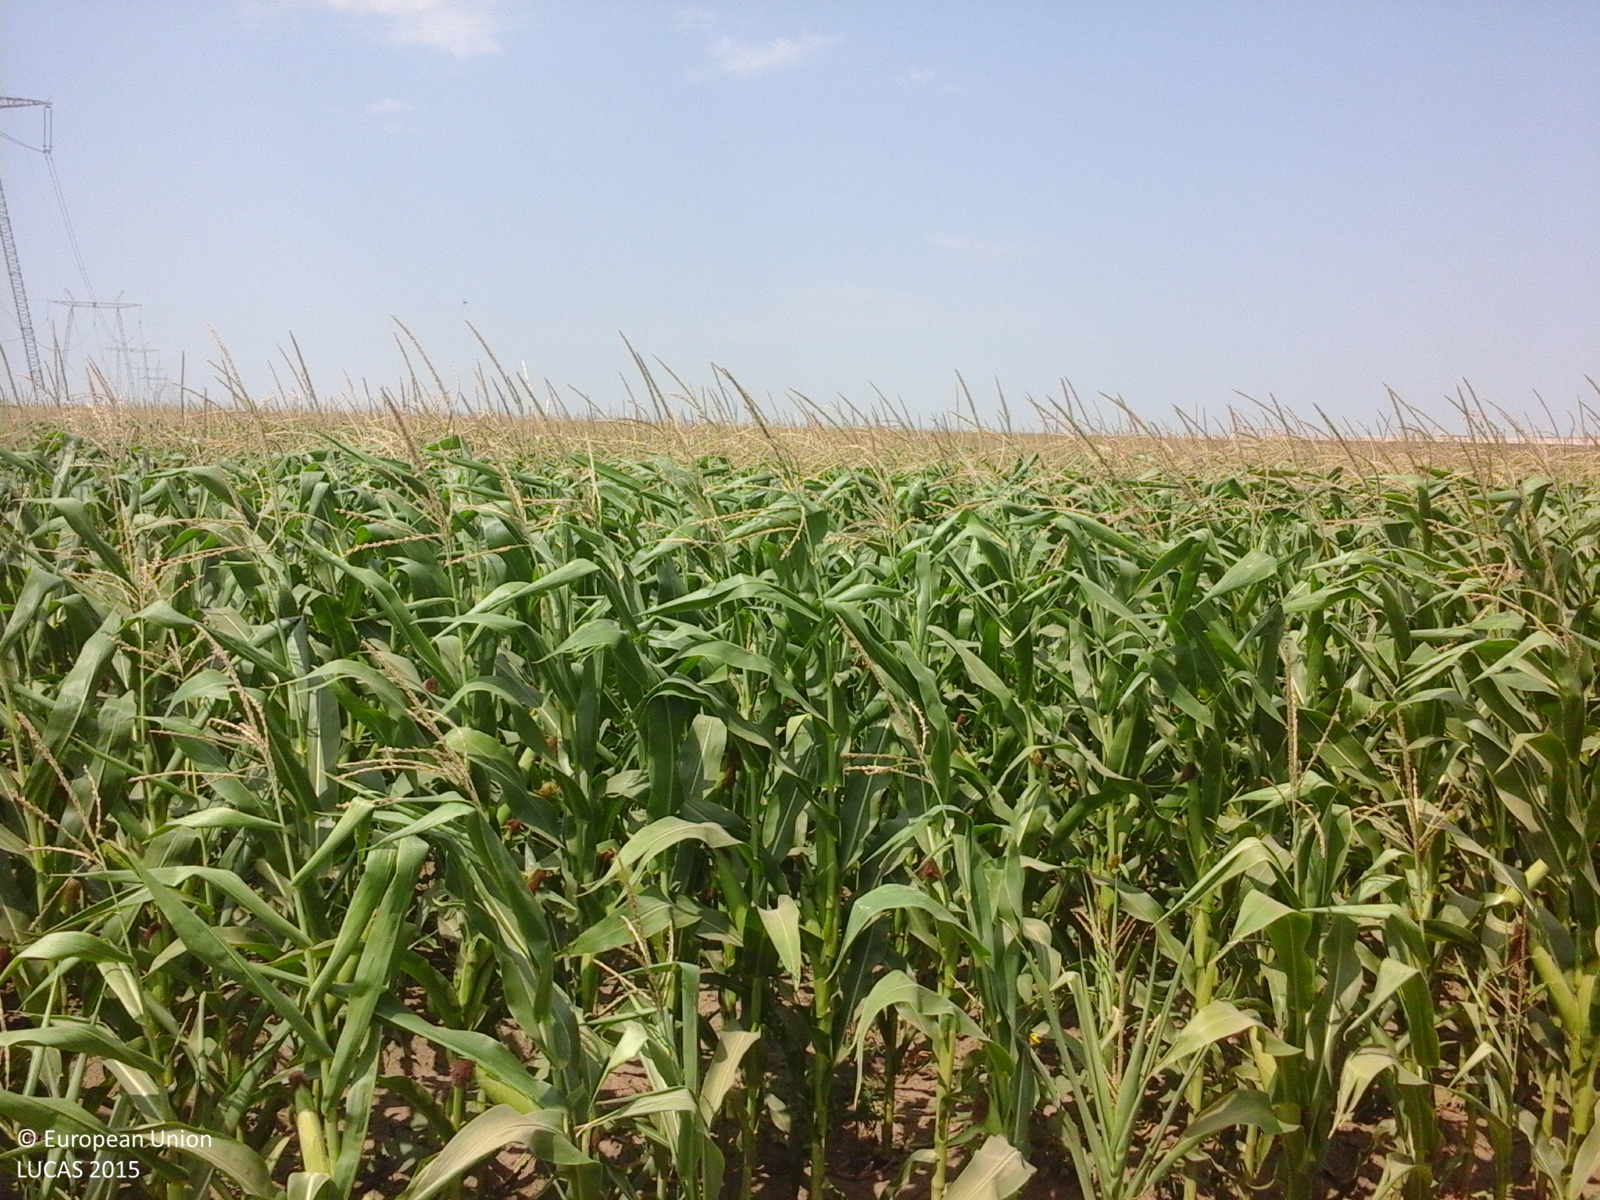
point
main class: Cropland
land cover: Maize
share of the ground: > 75 %
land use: Agriculture (excluding fallow land and kitchen gardens)
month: July
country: RO
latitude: 44.6621
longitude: 27.5637
